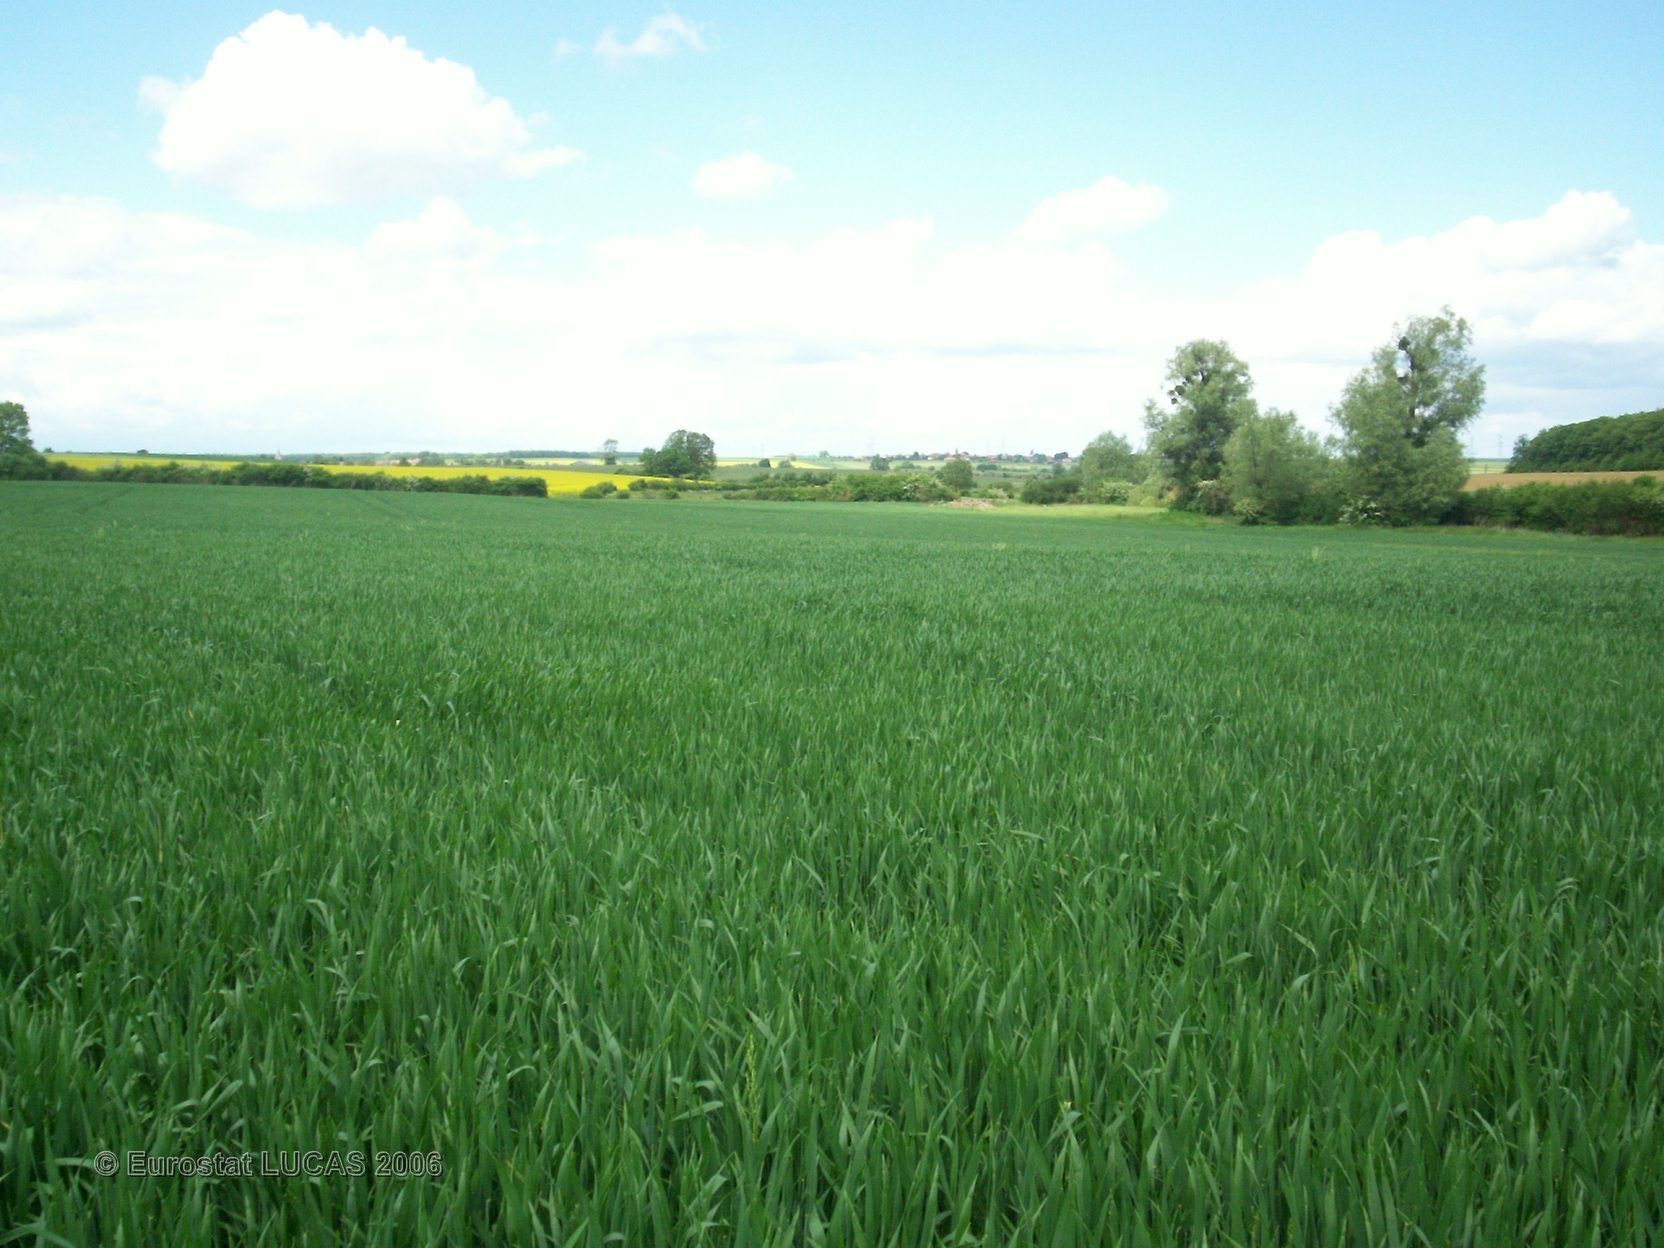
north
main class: Cropland
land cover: Common wheat
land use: Agriculture (excluding fallow land and kitchen gardens)
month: May
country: FR
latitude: 49.2269
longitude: 5.8661
